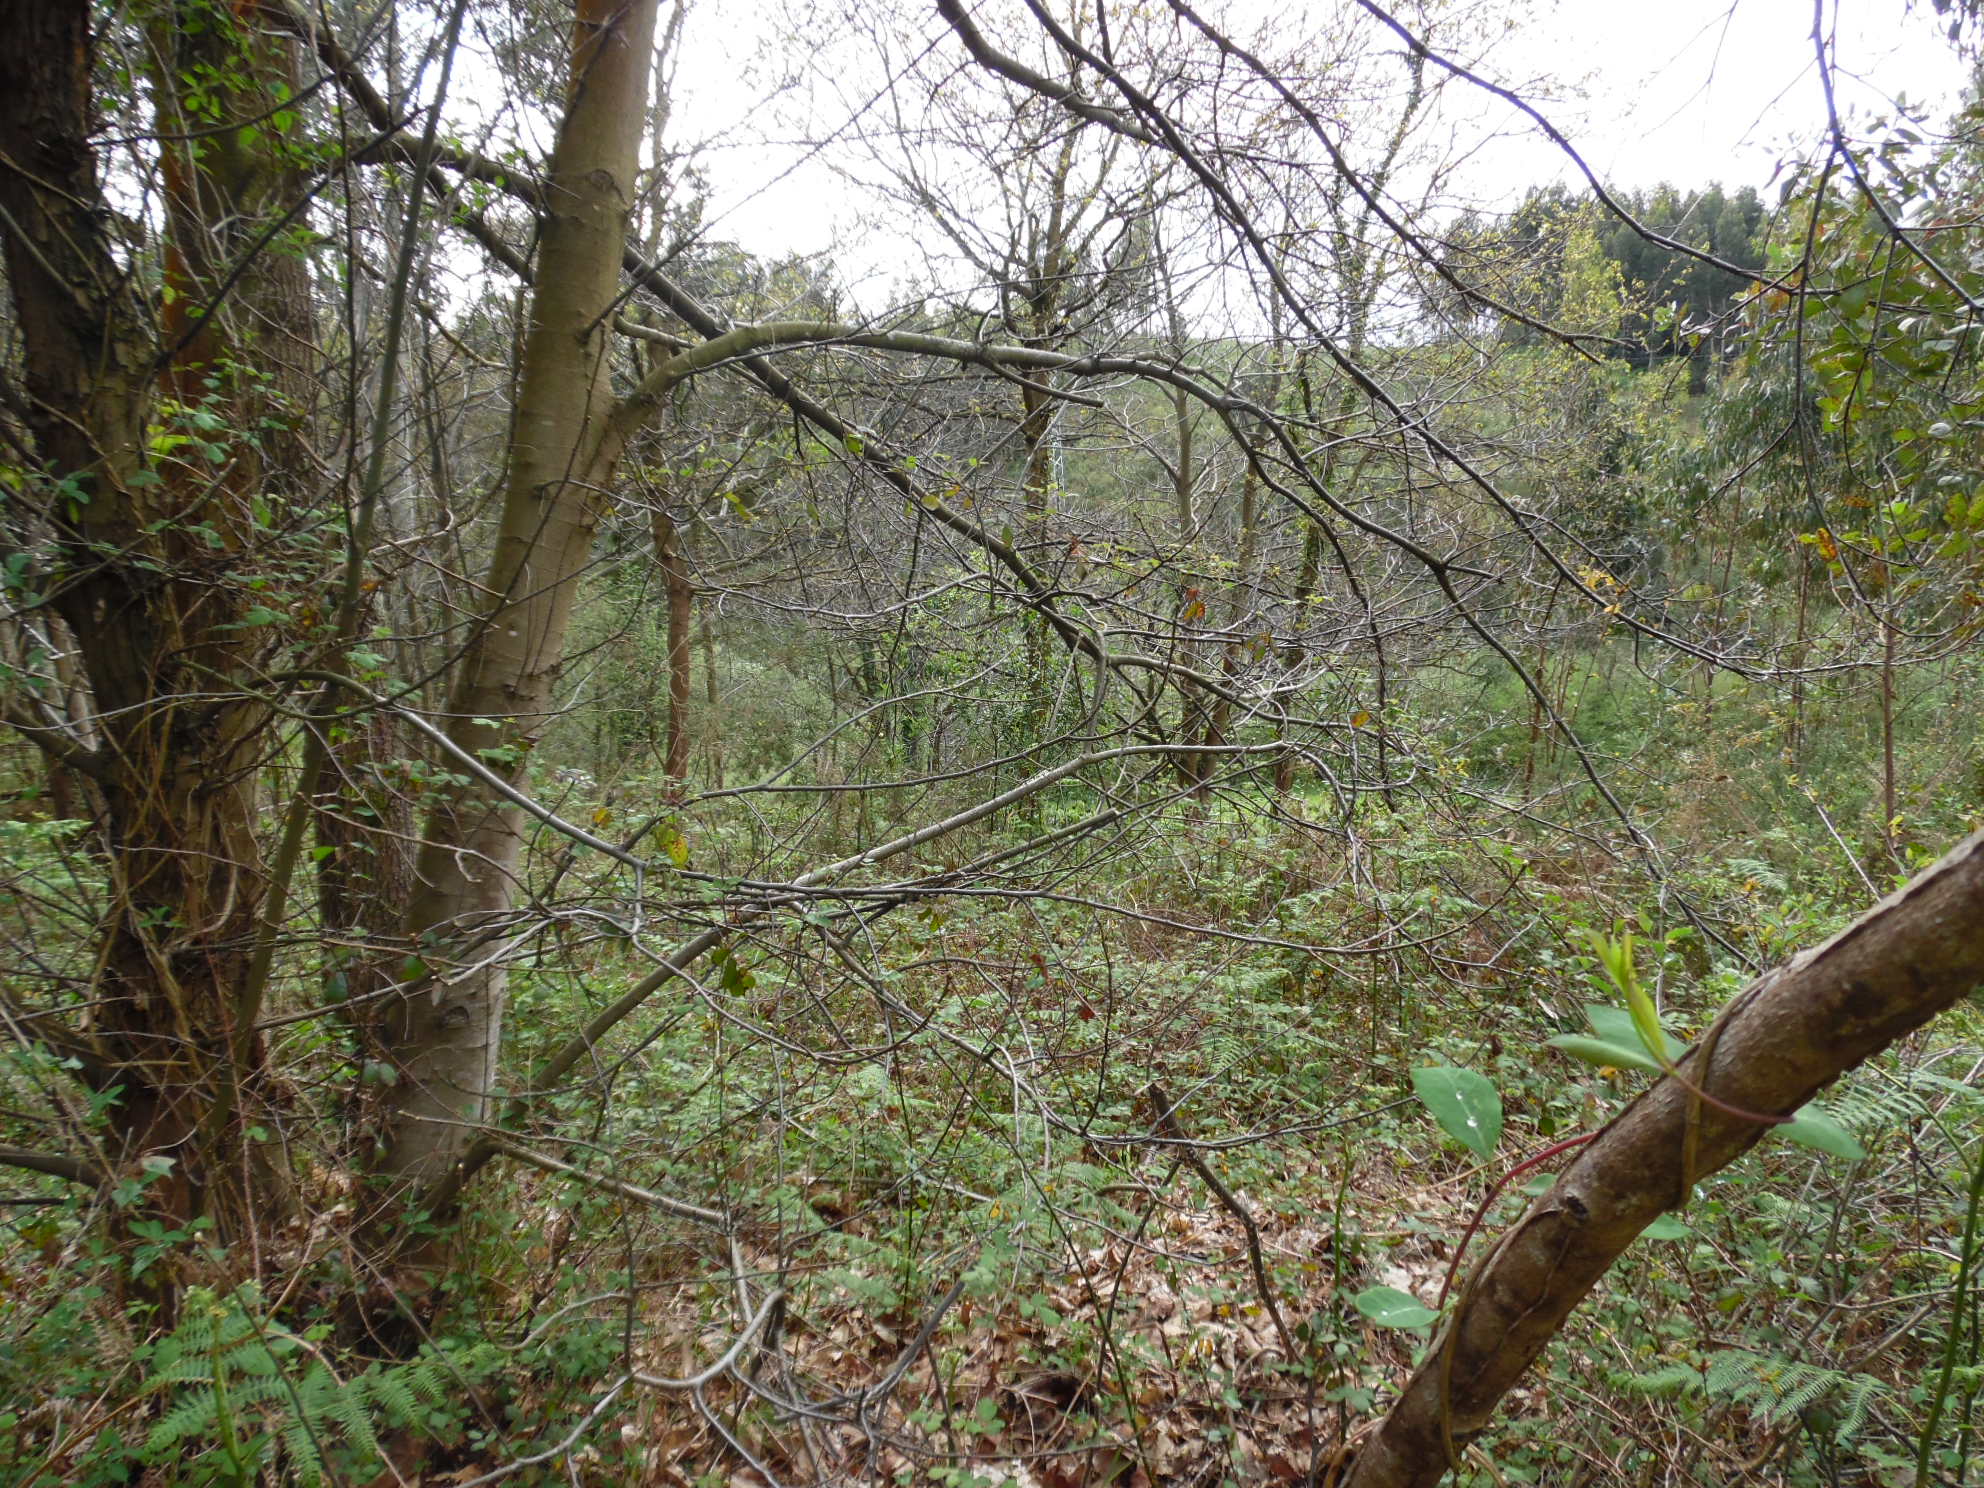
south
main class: Woodland
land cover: Broadleaved woodland
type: exotic forest
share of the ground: > 75 %
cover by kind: broadleaved forest trees 95 %, shrubs 5 %
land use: Forestry
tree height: > 5 m
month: April
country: ES
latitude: 43.5597
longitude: -5.8746
